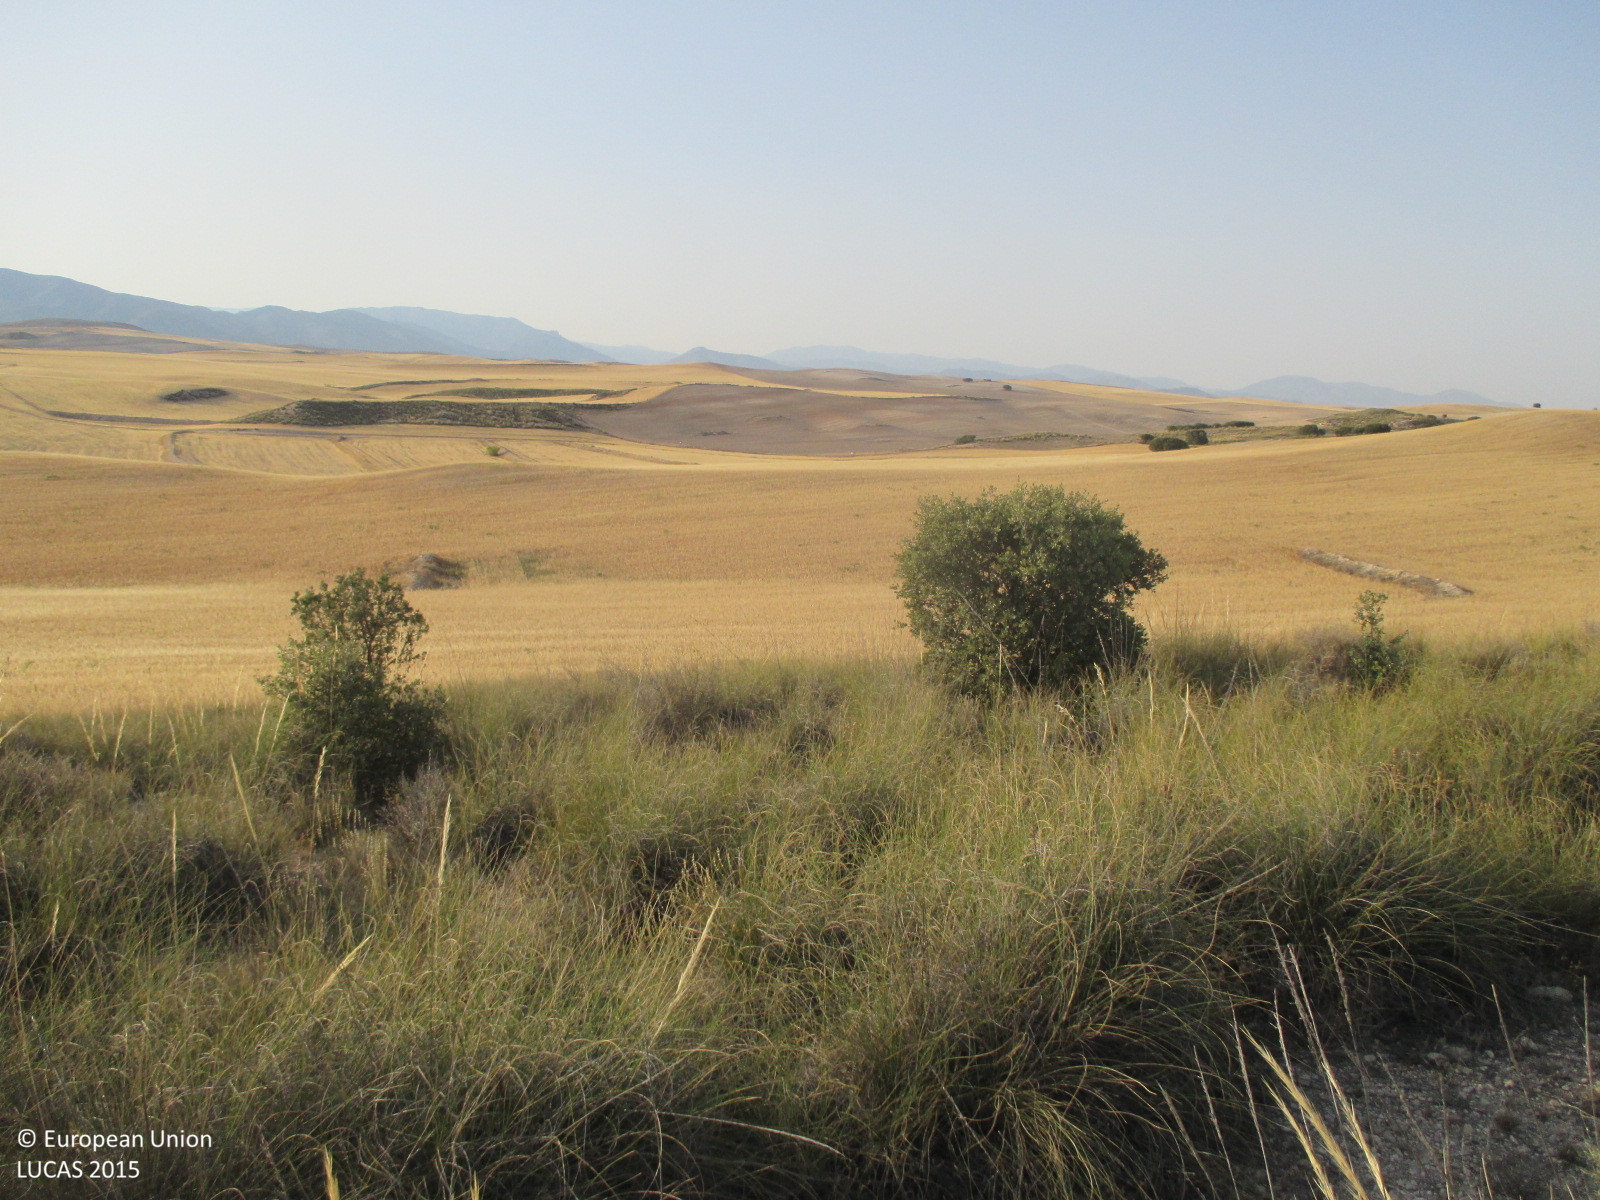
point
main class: Cropland
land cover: Oats
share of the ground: 25 - 50 %
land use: Agriculture (excluding fallow land and kitchen gardens)
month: June
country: ES
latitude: 37.7728
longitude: -2.4200
